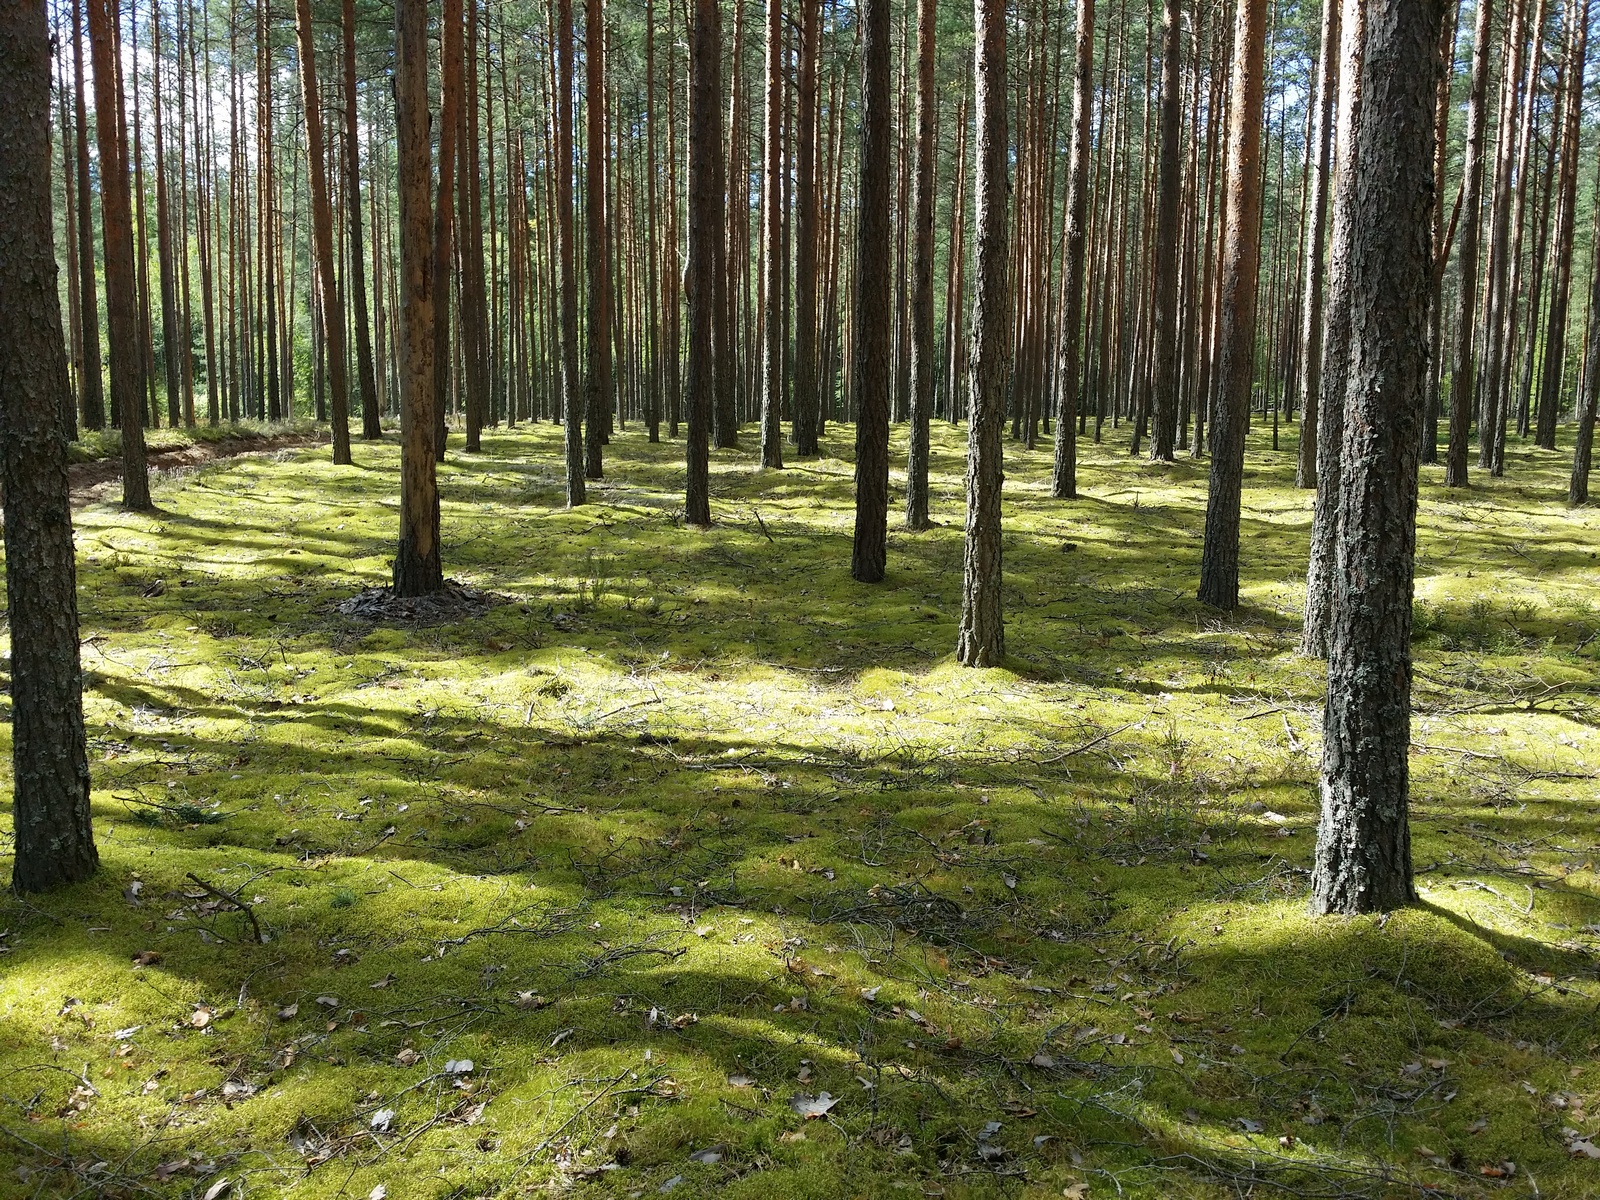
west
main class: Woodland
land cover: Pine dominated coniferous woodland
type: hemiboreal forest and nemoral coniferous forest and mixed broadleaved-coniferous forest
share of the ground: 50 - 75 %
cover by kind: coniferous forest trees 70 %, lichens and mosses 30 %
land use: Forestry
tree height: > 5 m
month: August
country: LV
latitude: 57.3466
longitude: 27.6791
